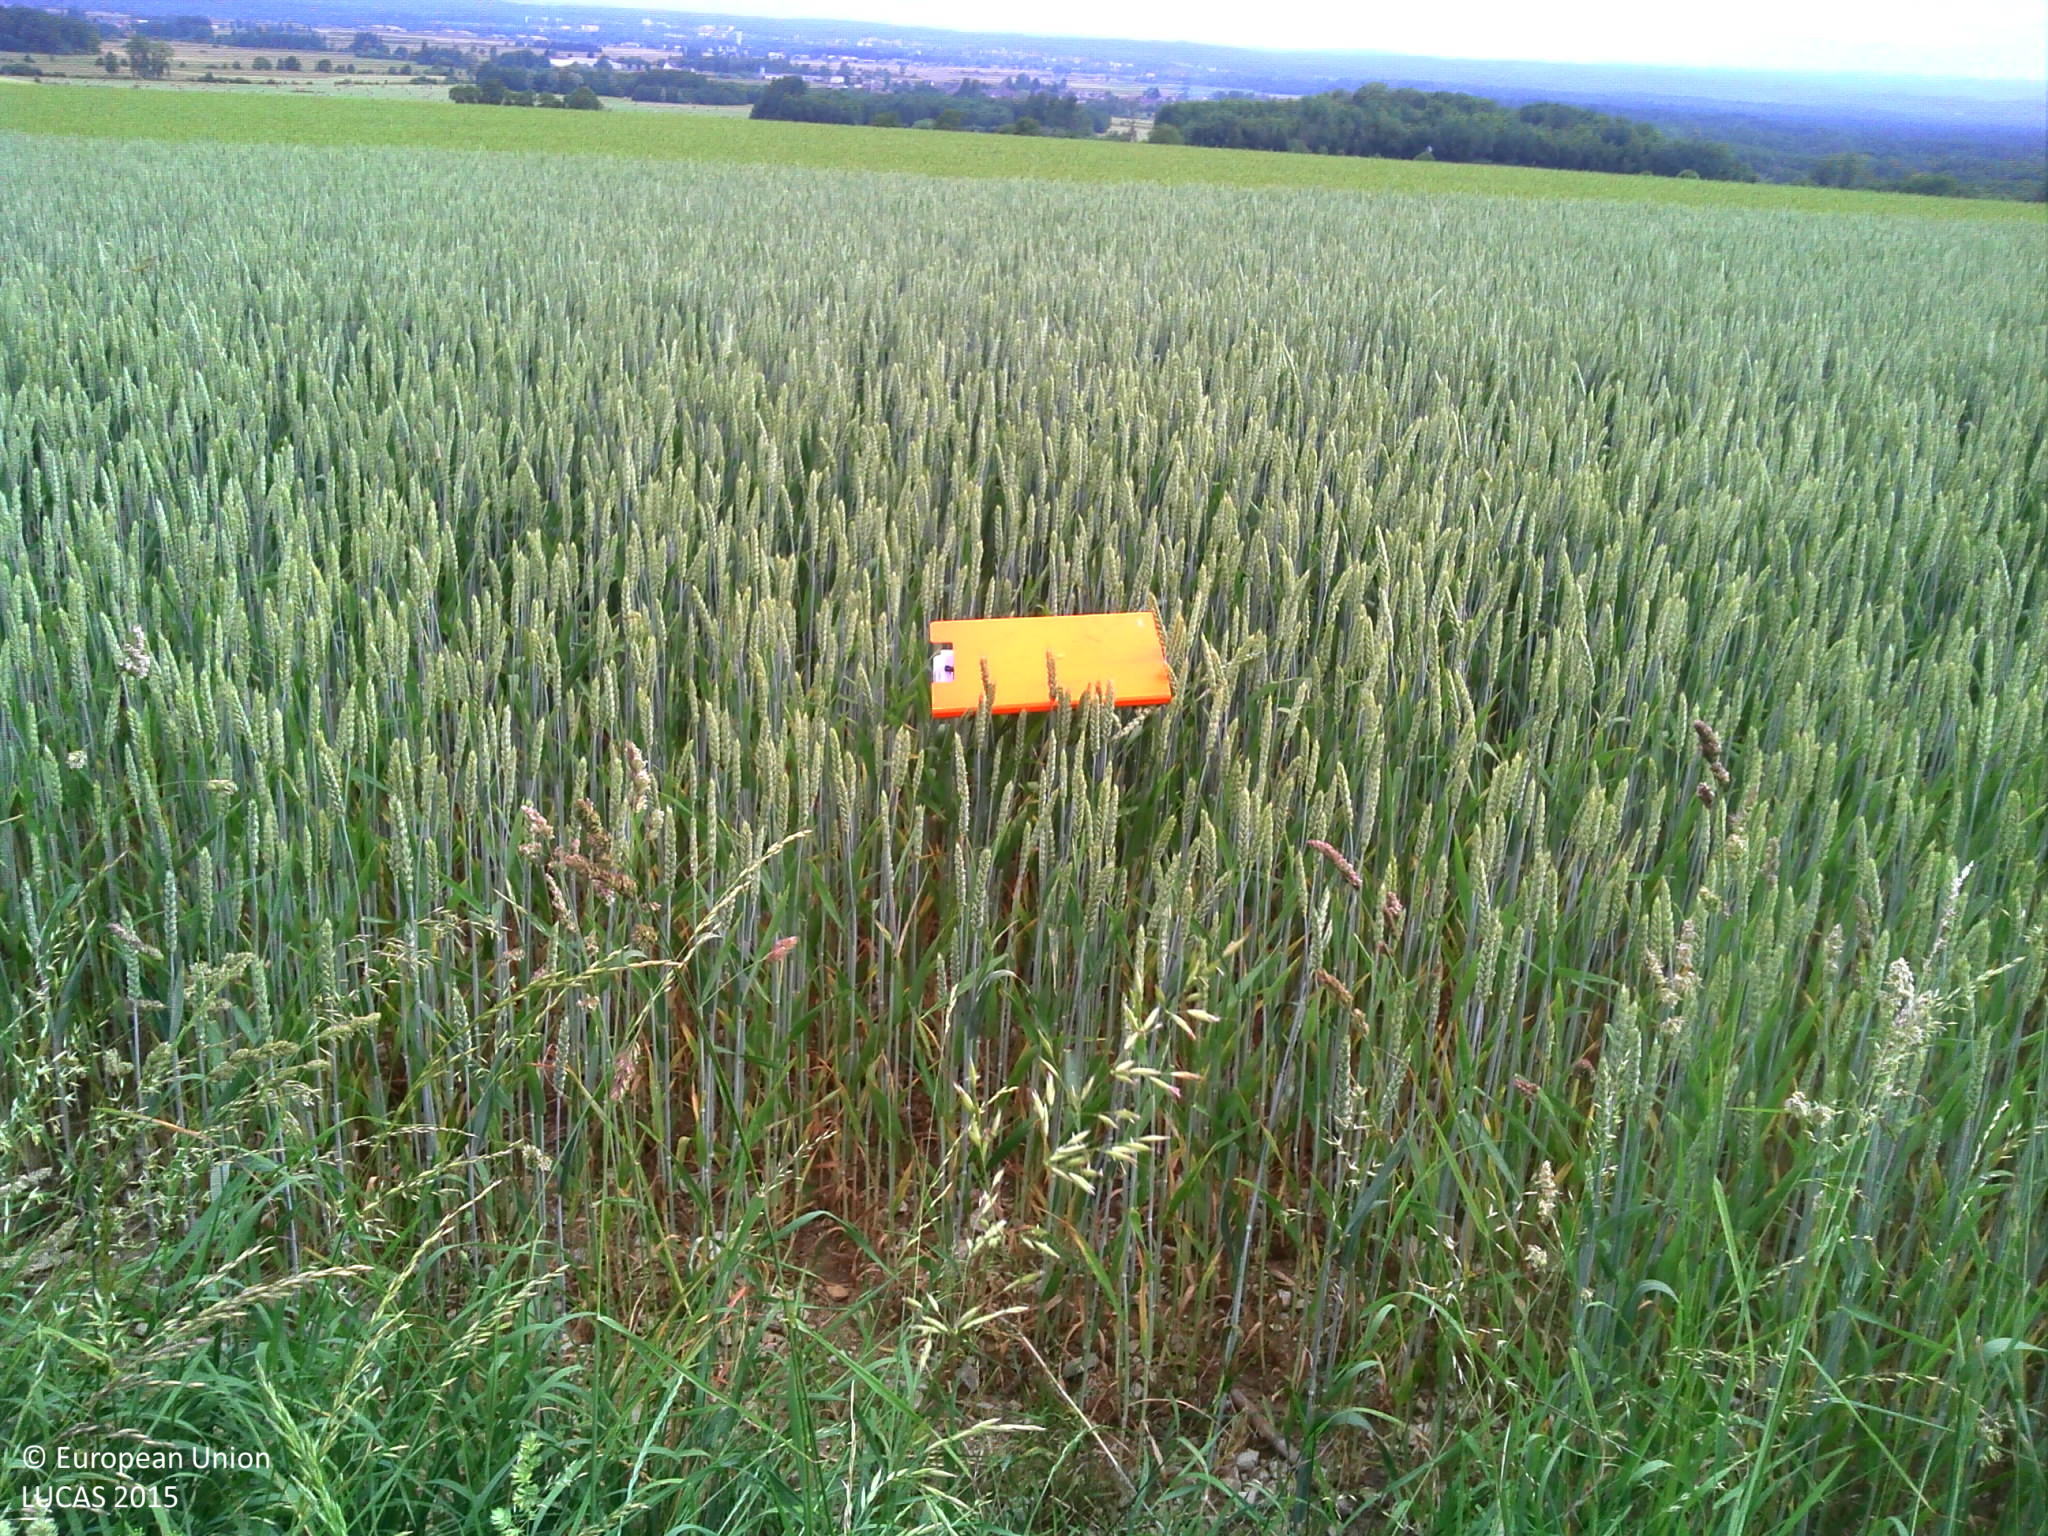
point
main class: Cropland
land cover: Common wheat
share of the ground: > 75 %
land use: Agriculture (excluding fallow land and kitchen gardens)
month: June
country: FR
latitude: 47.7491
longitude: 6.3599
